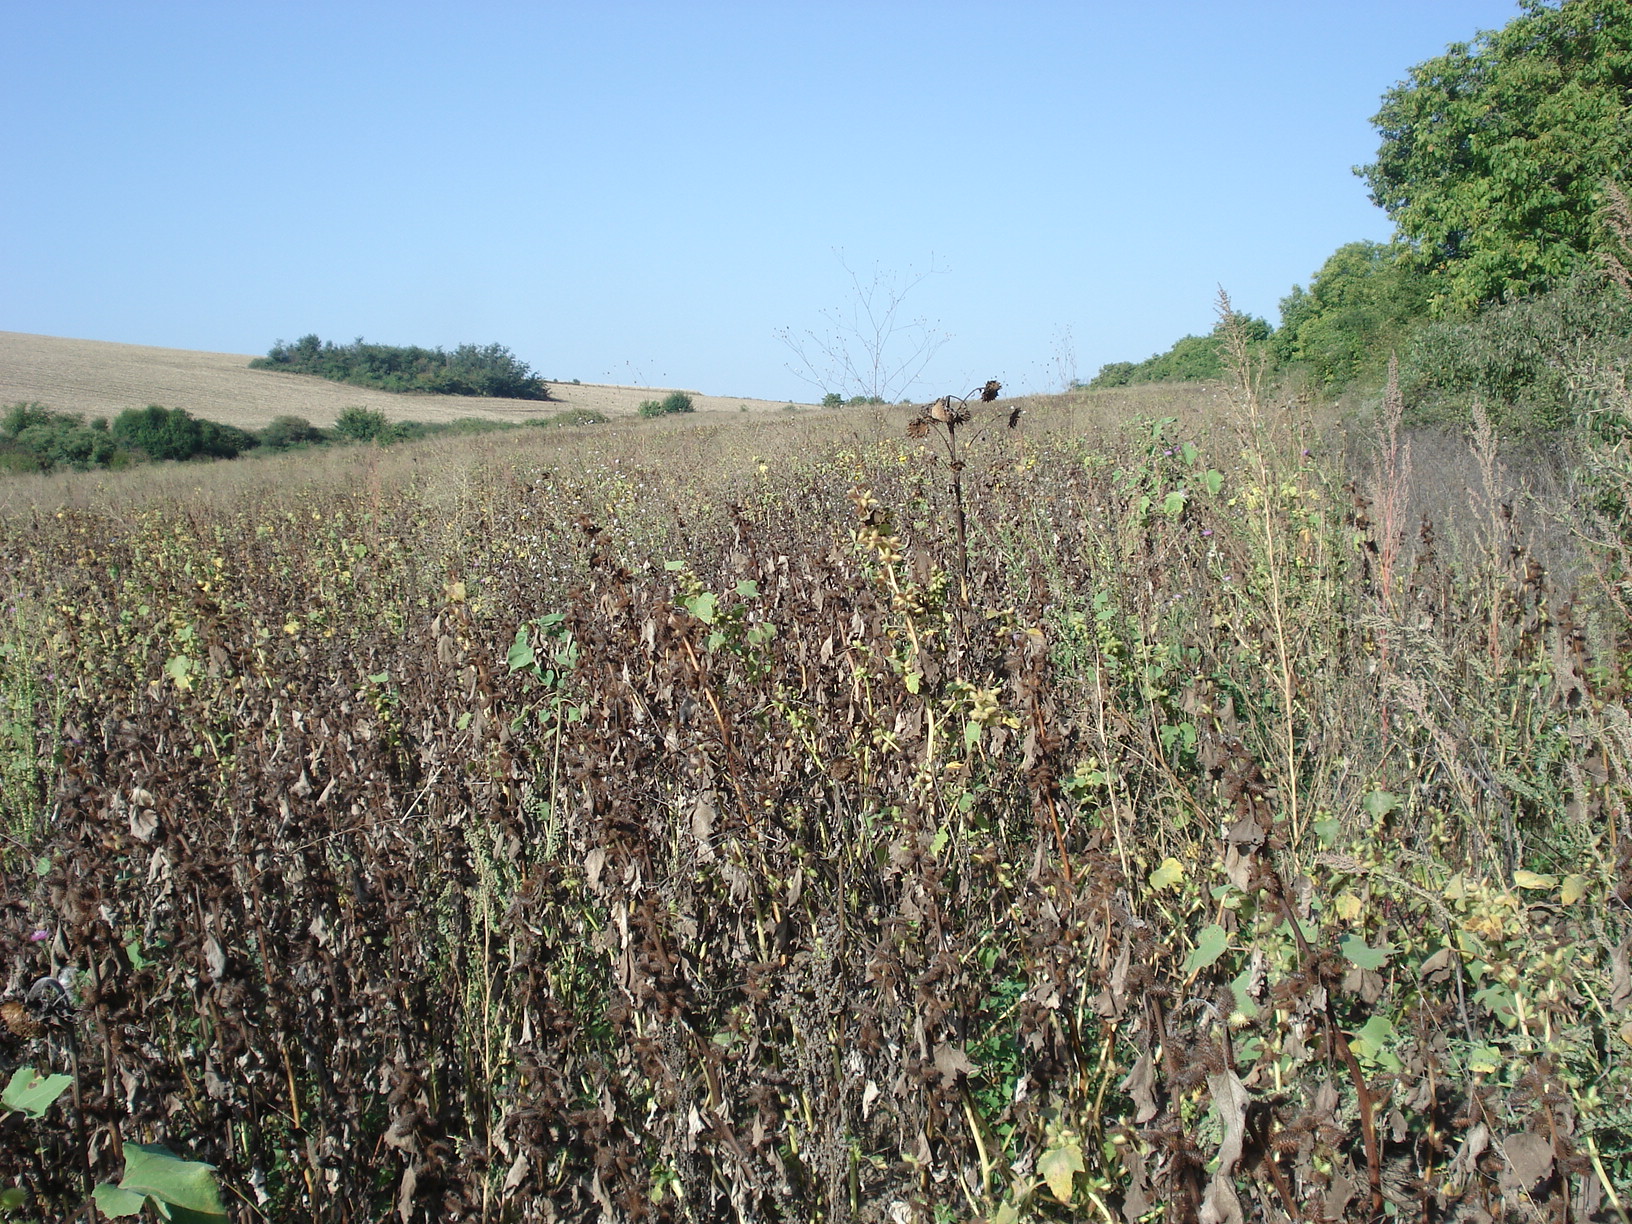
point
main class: Grassland
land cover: Spontaneously vegetated surfaces
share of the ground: > 75 %
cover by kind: herbaceous plants 100 %
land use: Fallow land
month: September
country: BG
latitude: 43.2490
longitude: 25.5117
